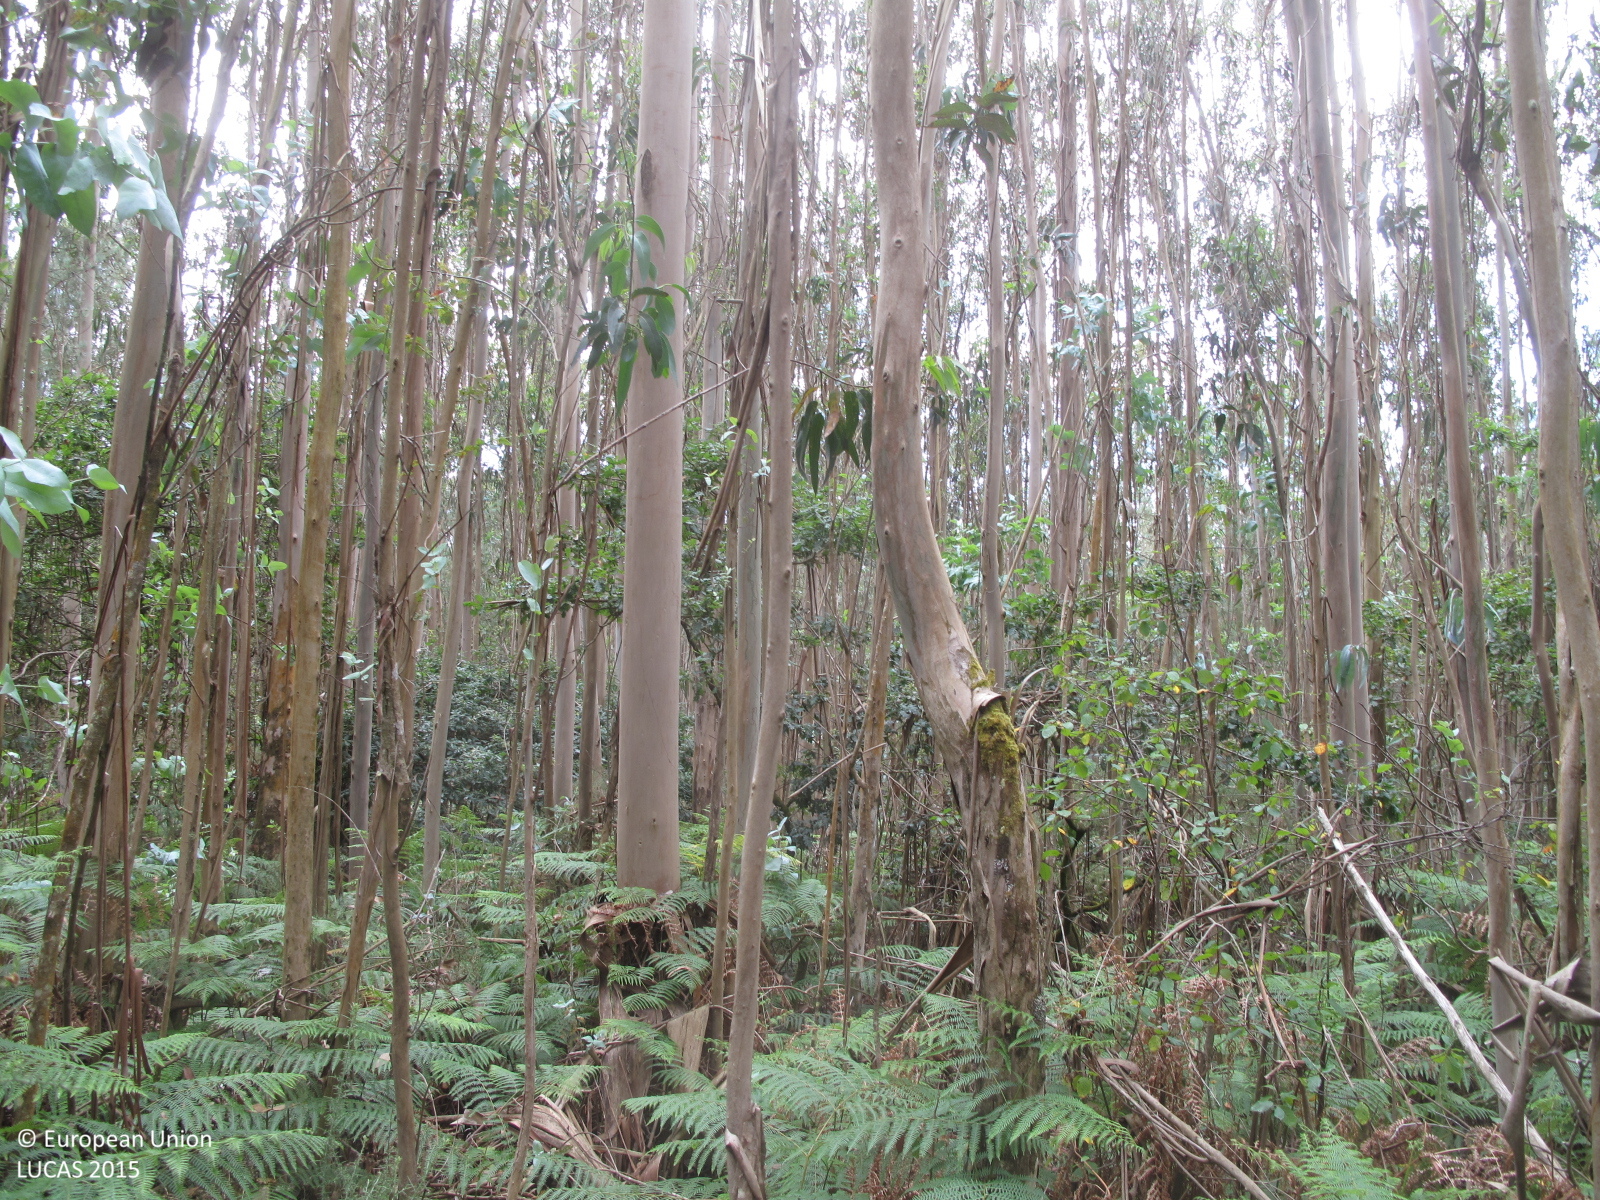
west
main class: Woodland
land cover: Broadleaved woodland
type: exotic forest
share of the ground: 50 - 75 %
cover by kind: broadleaved forest trees 60 %, herbaceous plants 20 %, shrubs 10 %, unconsolidated bare surface 10 %
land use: Forestry
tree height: > 5 m
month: July
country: ES
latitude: 42.9419
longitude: -9.2087
